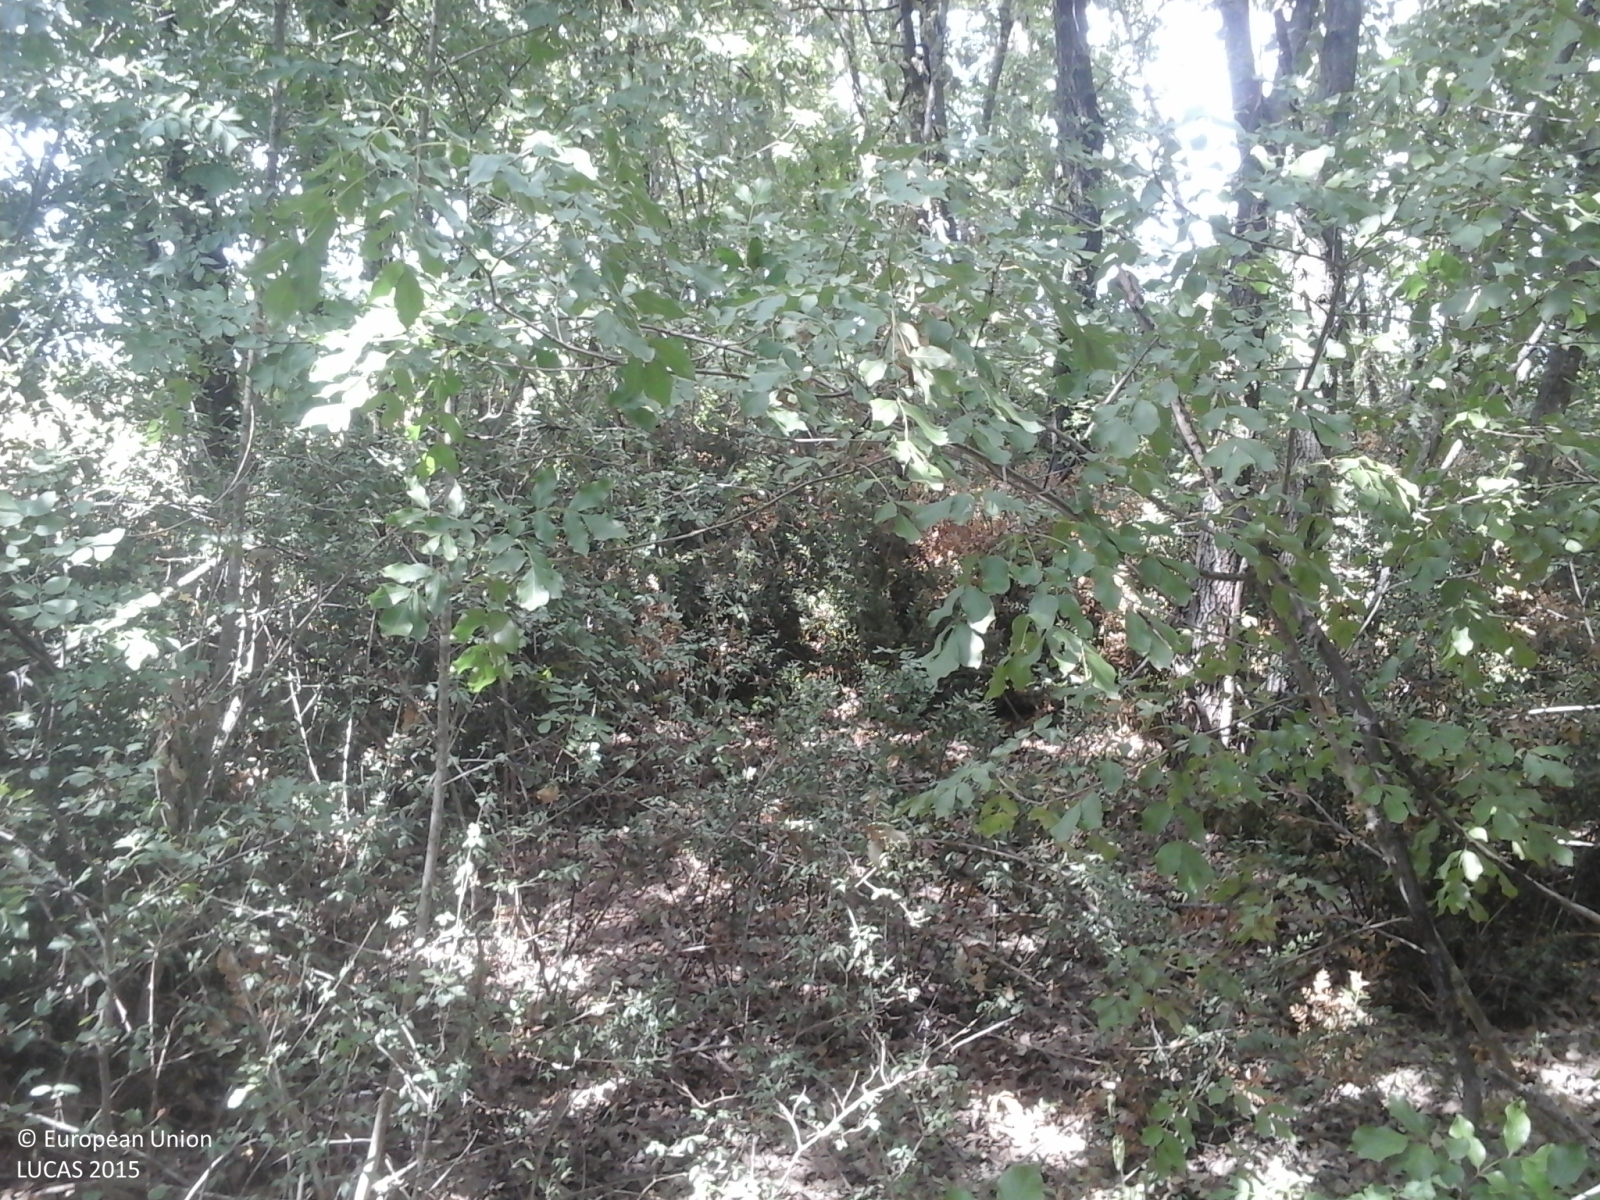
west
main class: Woodland
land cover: Broadleaved woodland
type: thermophilous deciduous forest
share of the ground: > 75 %
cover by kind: broadleaved forest trees 100 %
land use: Forestry
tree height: > 5 m
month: August
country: IT
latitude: 43.9319
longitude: 10.8822
